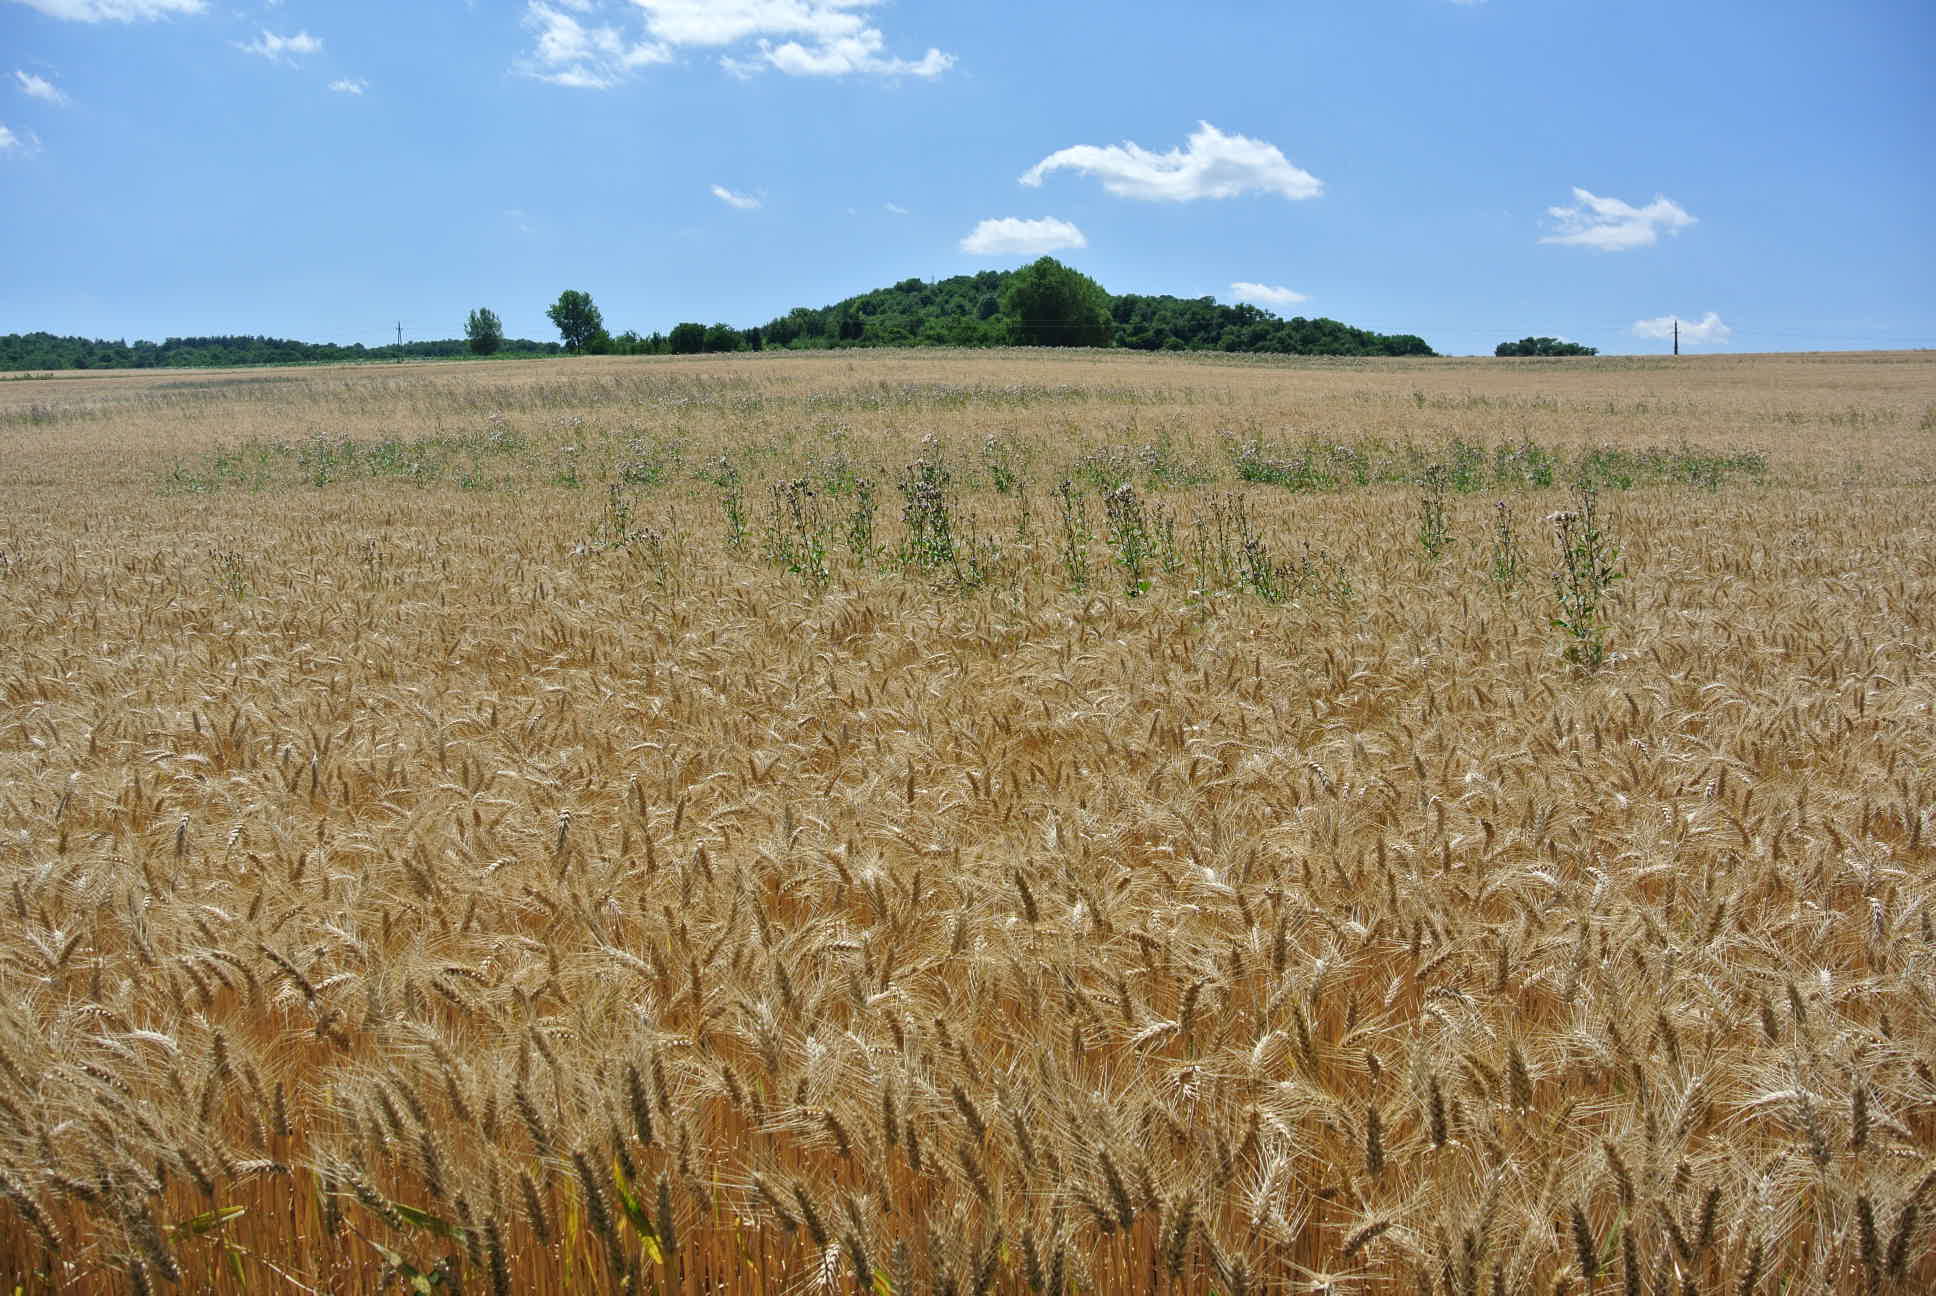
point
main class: Cropland
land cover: Durum wheat
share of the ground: > 75 %
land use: Agriculture (excluding fallow land and kitchen gardens)
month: July
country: AT
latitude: 47.7102
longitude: 16.4417
